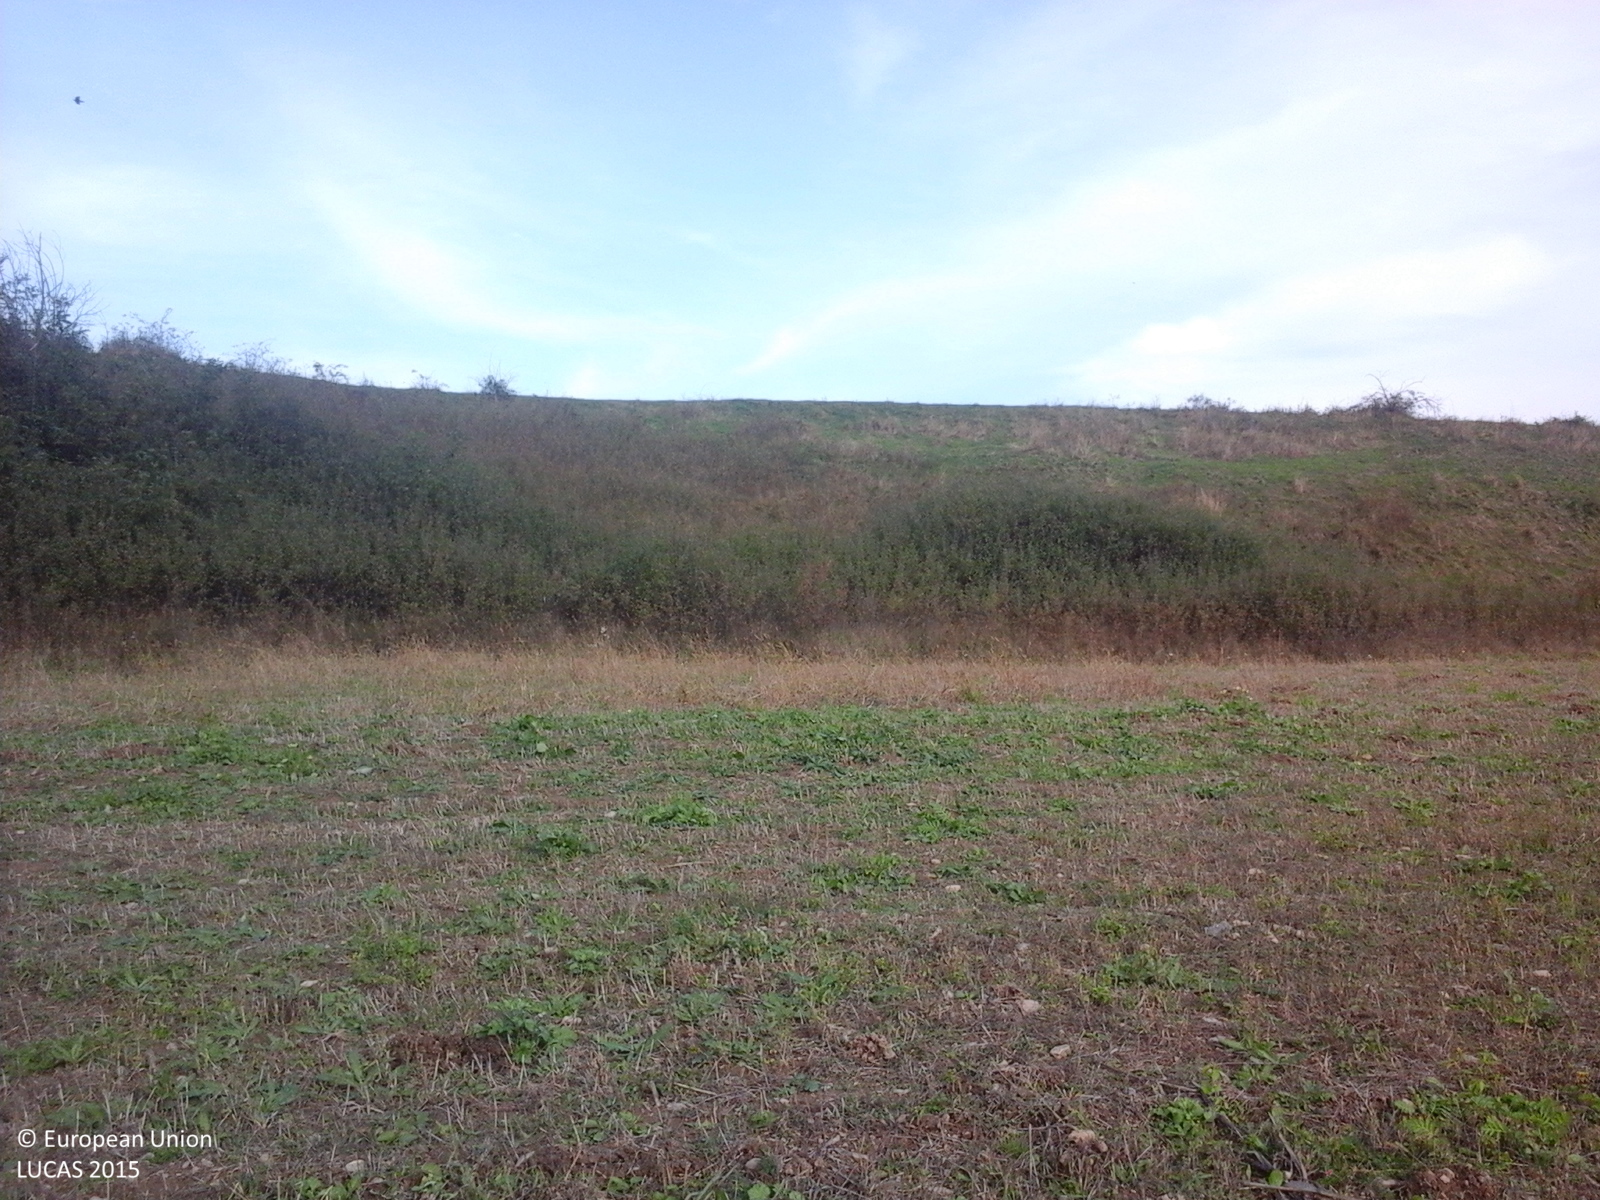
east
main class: Grassland
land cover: Grassland without tree/shrub cover
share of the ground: > 75 %
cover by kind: herbaceous plants 100 %
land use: Agriculture (excluding fallow land and kitchen gardens)
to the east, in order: Grassland without tree/shrub cover; Grassland with sparse tree/shrub cover; Grassland without tree/shrub cover; Maize; Common wheat; Other bare soil; Grassland without tree/shrub cover; Other bare soil; Maize
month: October
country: RO
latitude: 45.7908
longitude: 25.0542
